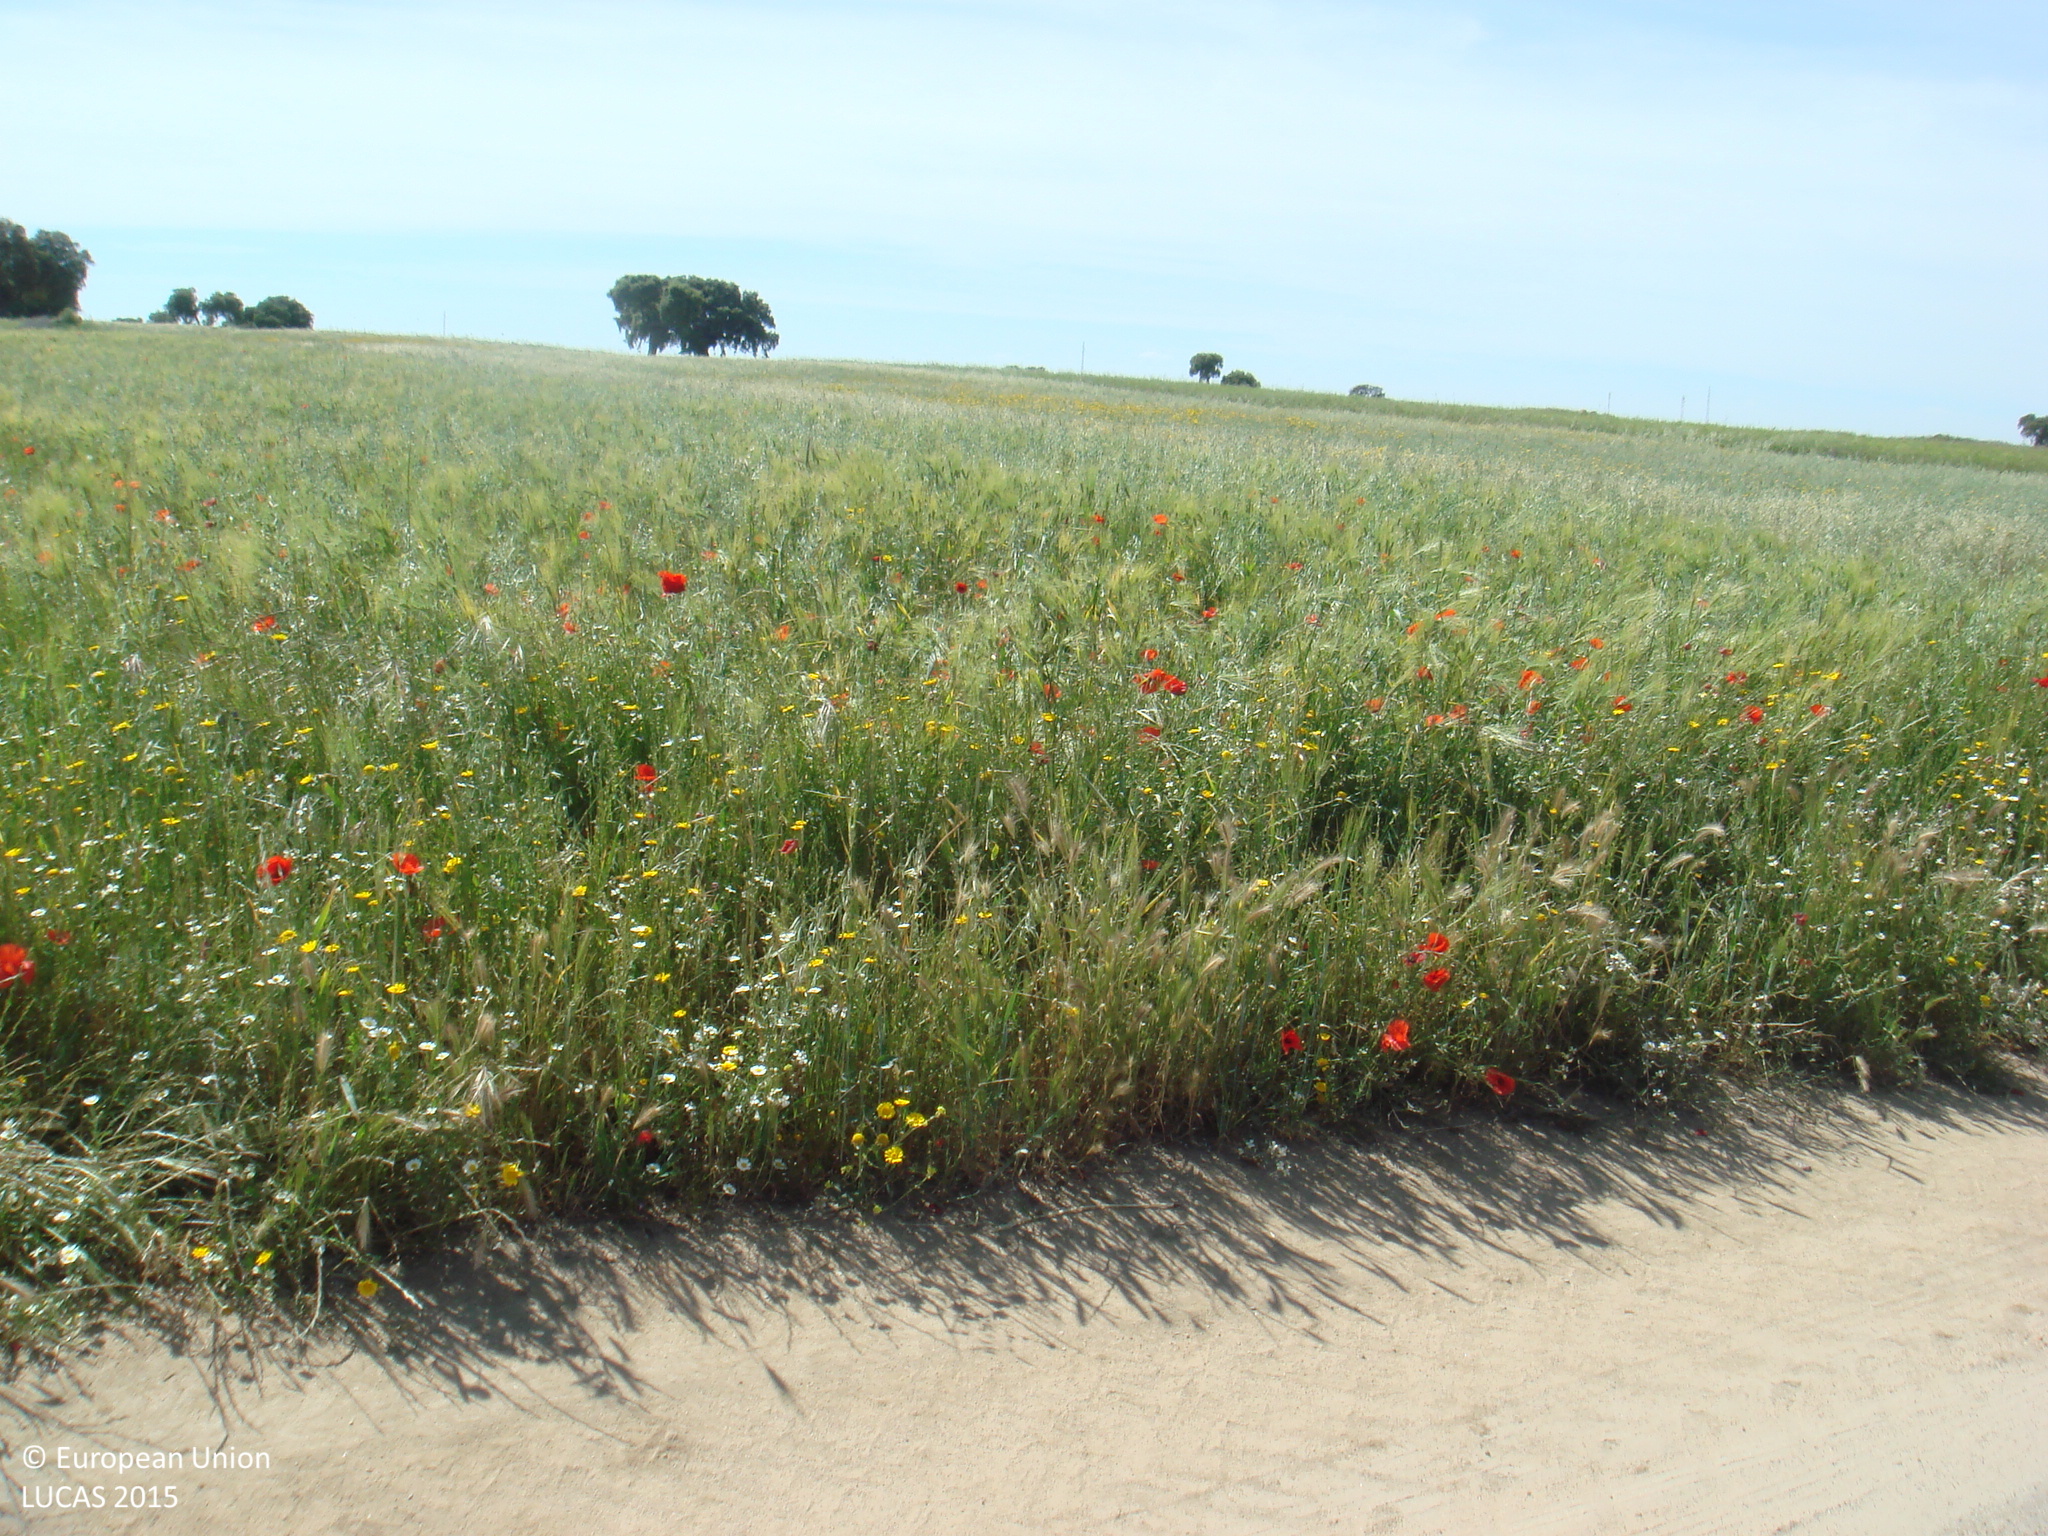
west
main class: Cropland
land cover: Mixed cereals for fodder
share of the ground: 25 - 50 %
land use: Agriculture (excluding fallow land and kitchen gardens)
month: April
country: ES
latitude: 38.4804
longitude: -5.1263
